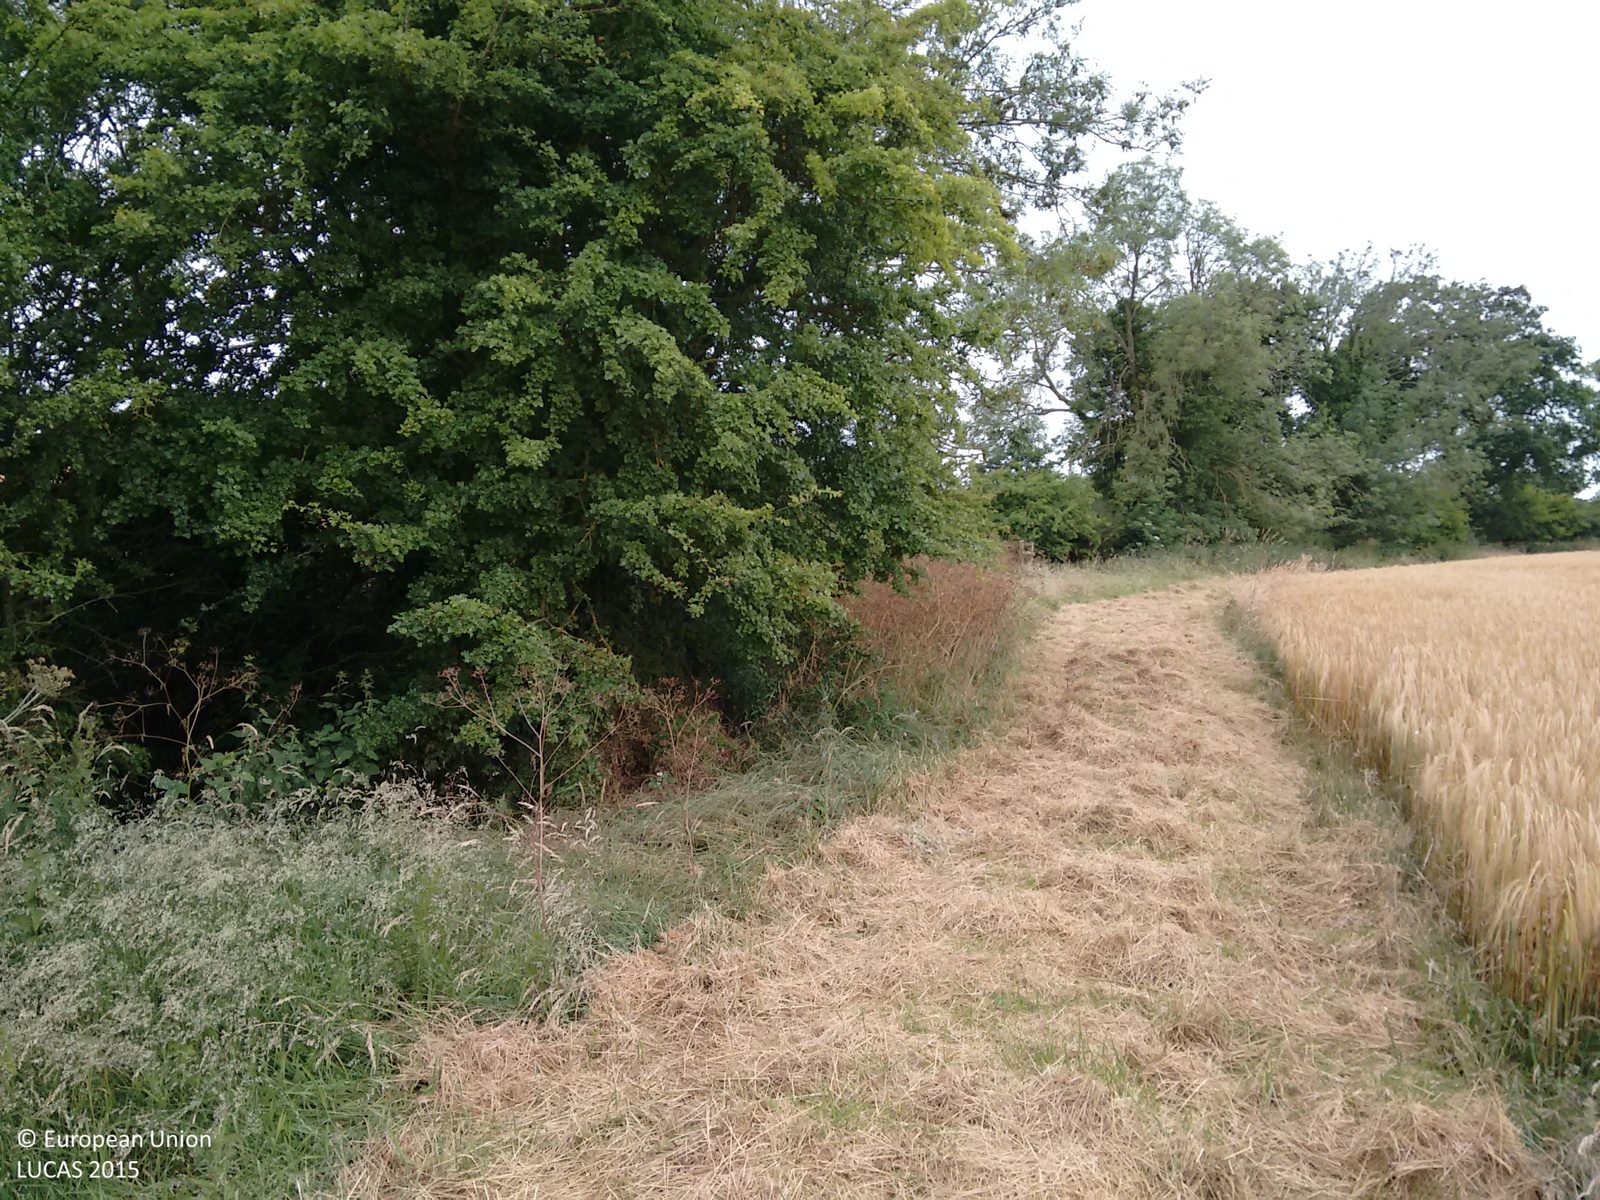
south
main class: Cropland
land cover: Barley
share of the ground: > 75 %
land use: Agriculture (excluding fallow land and kitchen gardens)
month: July
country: GB
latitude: 53.1918
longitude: -2.8080
